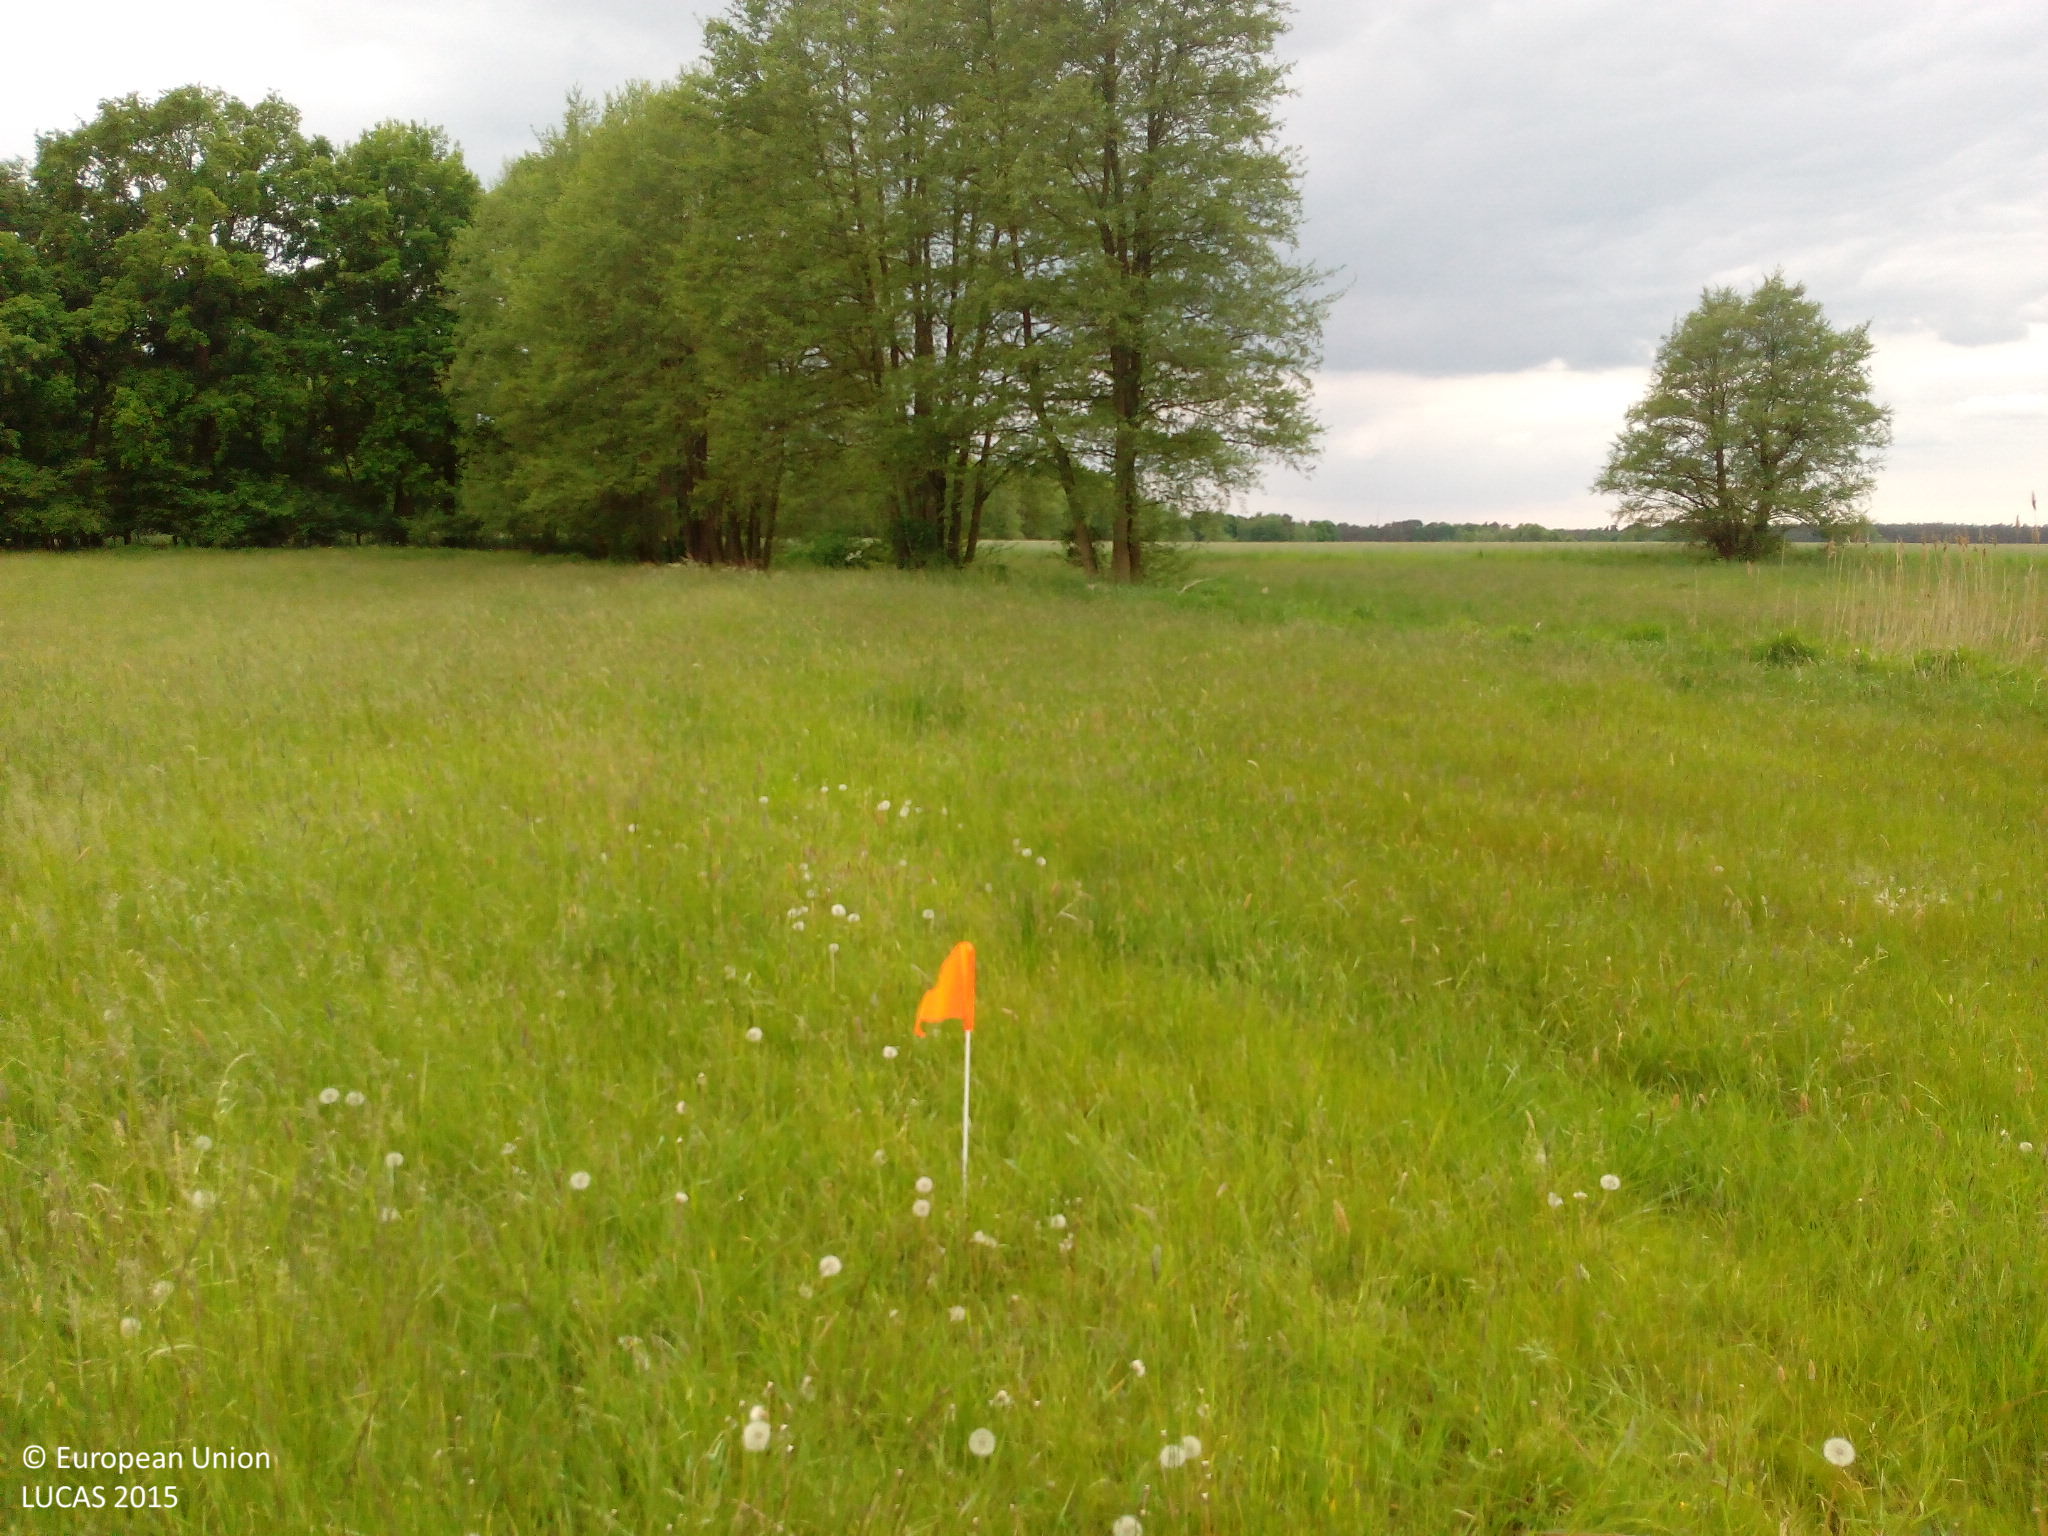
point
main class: Grassland
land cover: Grassland without tree/shrub cover
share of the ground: > 75 %
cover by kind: herbaceous plants 100 %
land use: Agriculture (excluding fallow land and kitchen gardens)
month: May
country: DE
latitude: 51.7687
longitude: 14.0440
